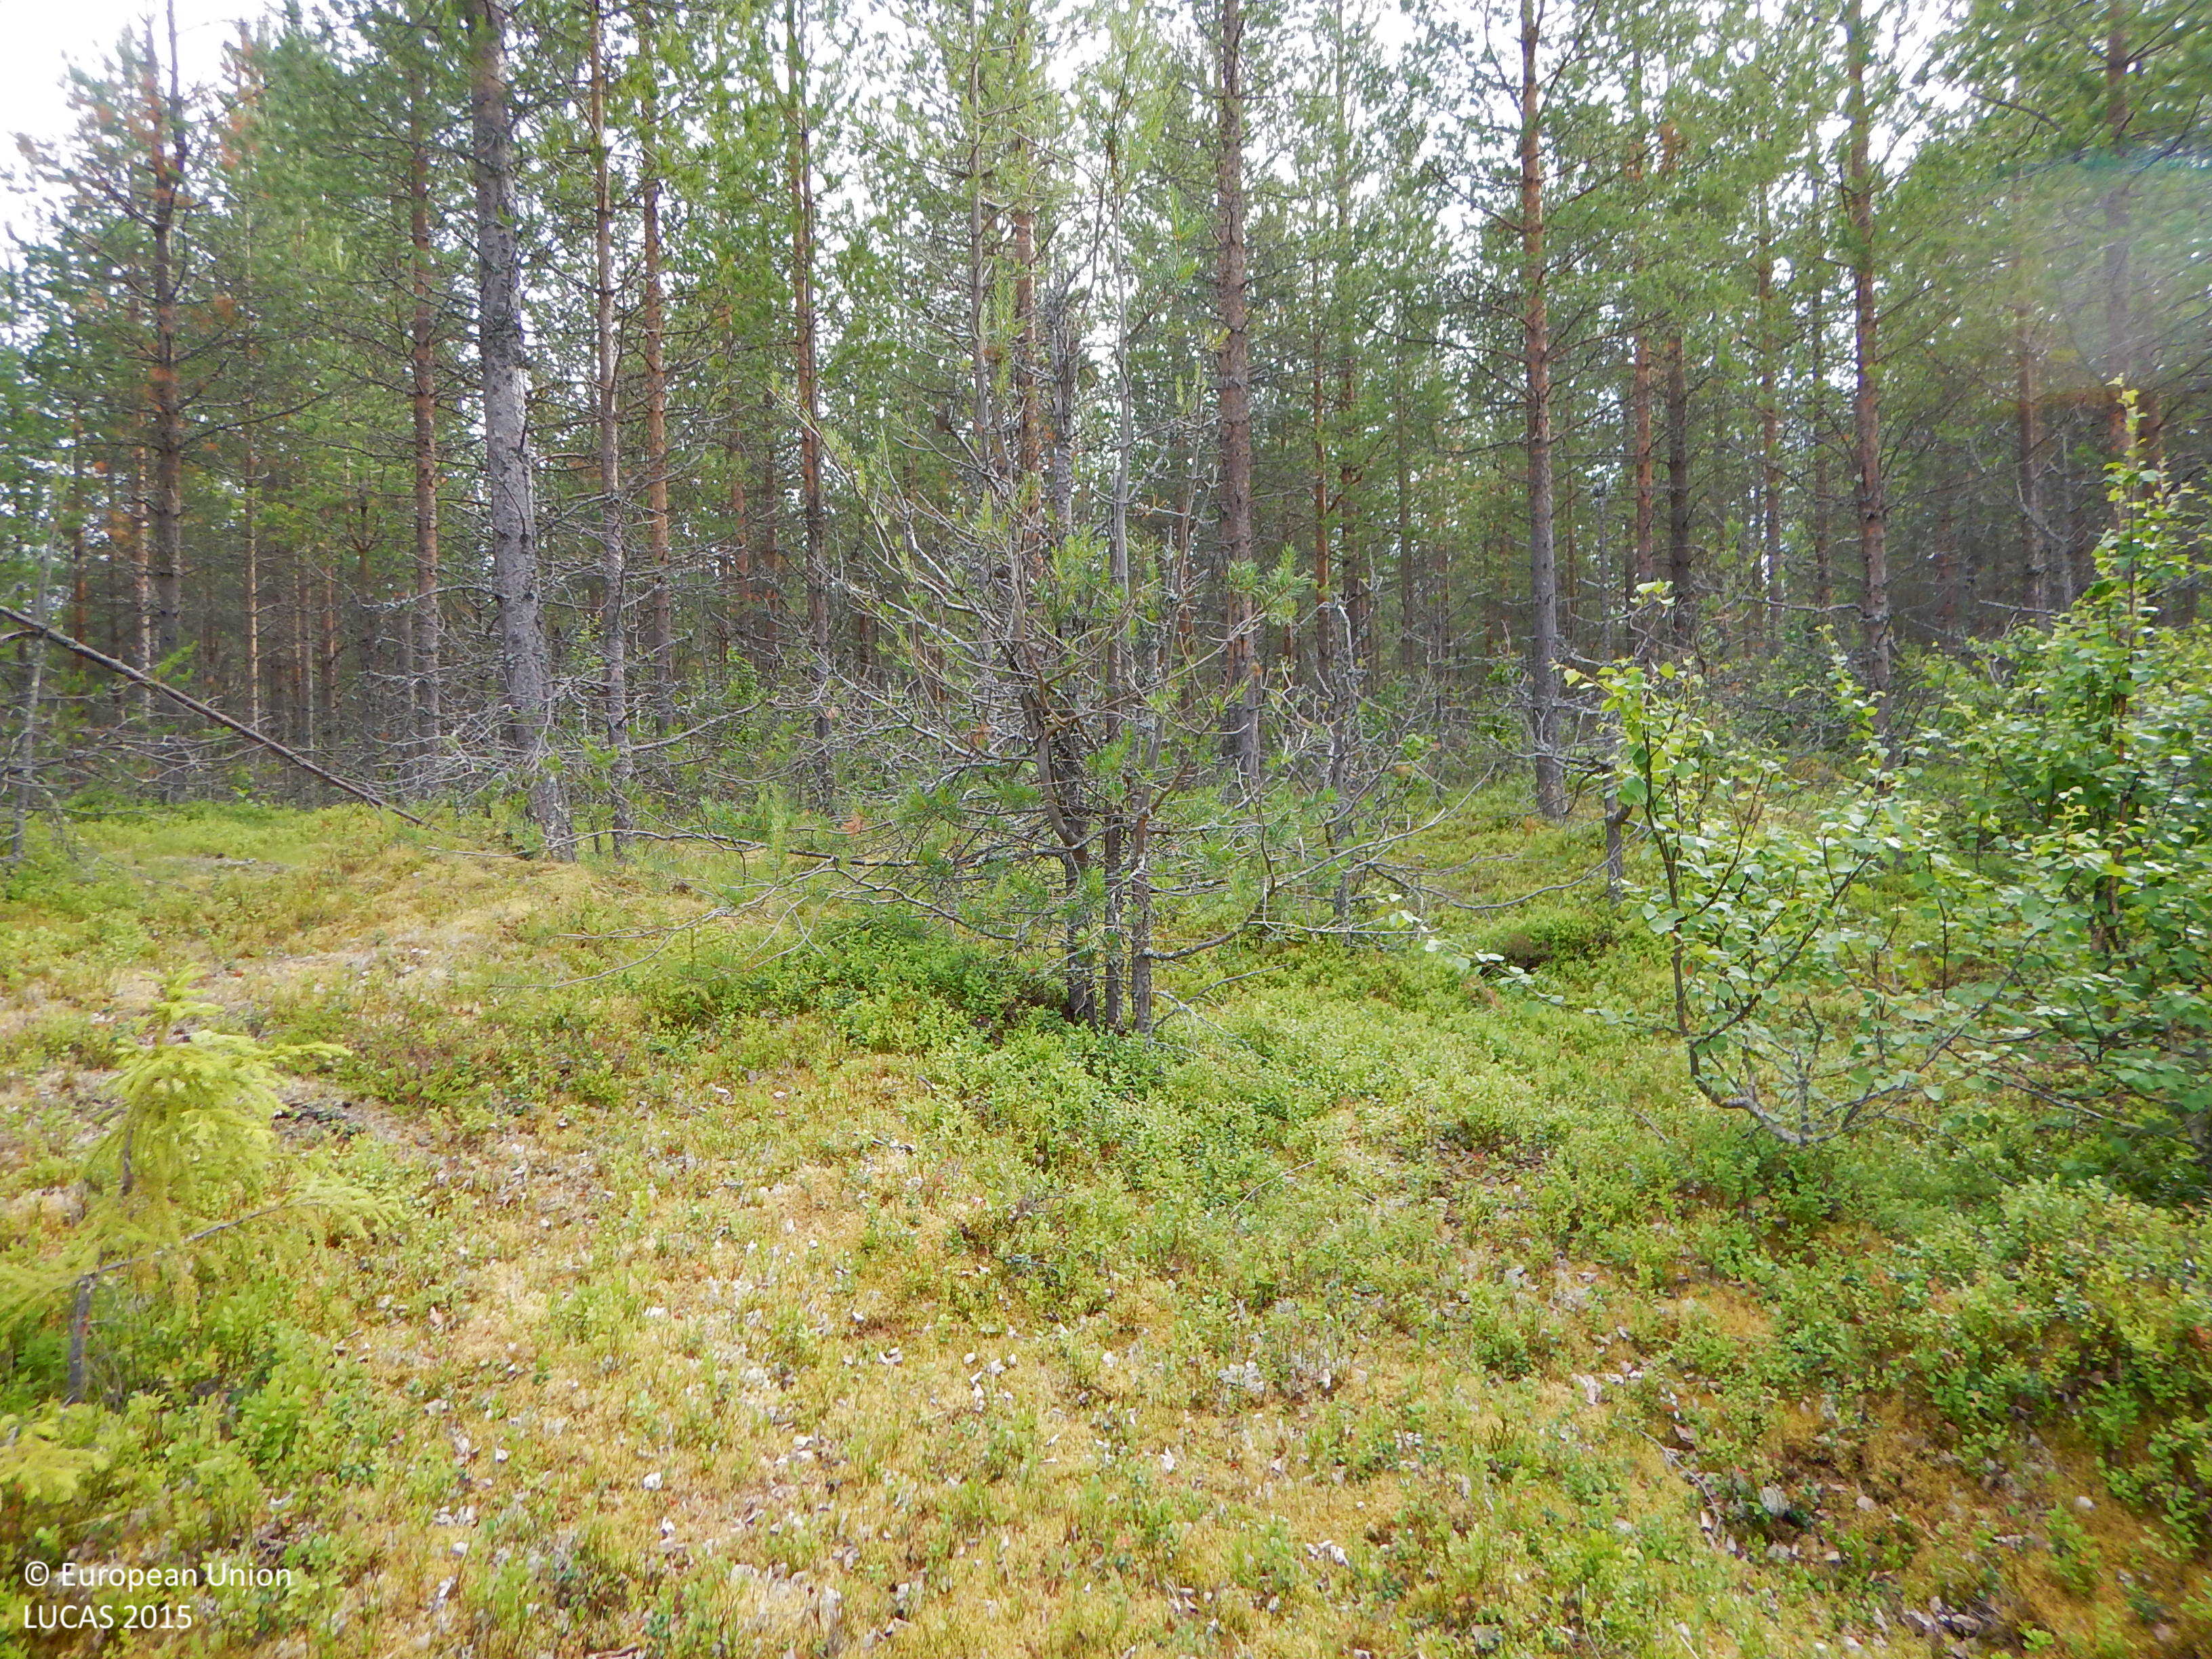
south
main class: Woodland
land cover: Pine dominated mixed woodland
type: boreal forest
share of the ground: 50 - 75 %
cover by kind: coniferous forest trees 35 %, shrubs 20 %, broadleaved forest trees 15 %, herbaceous plants 15 %, lichens and mosses 15 %
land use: Forestry
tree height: < 5 m
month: July
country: SE
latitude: 64.6645
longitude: 20.2999
